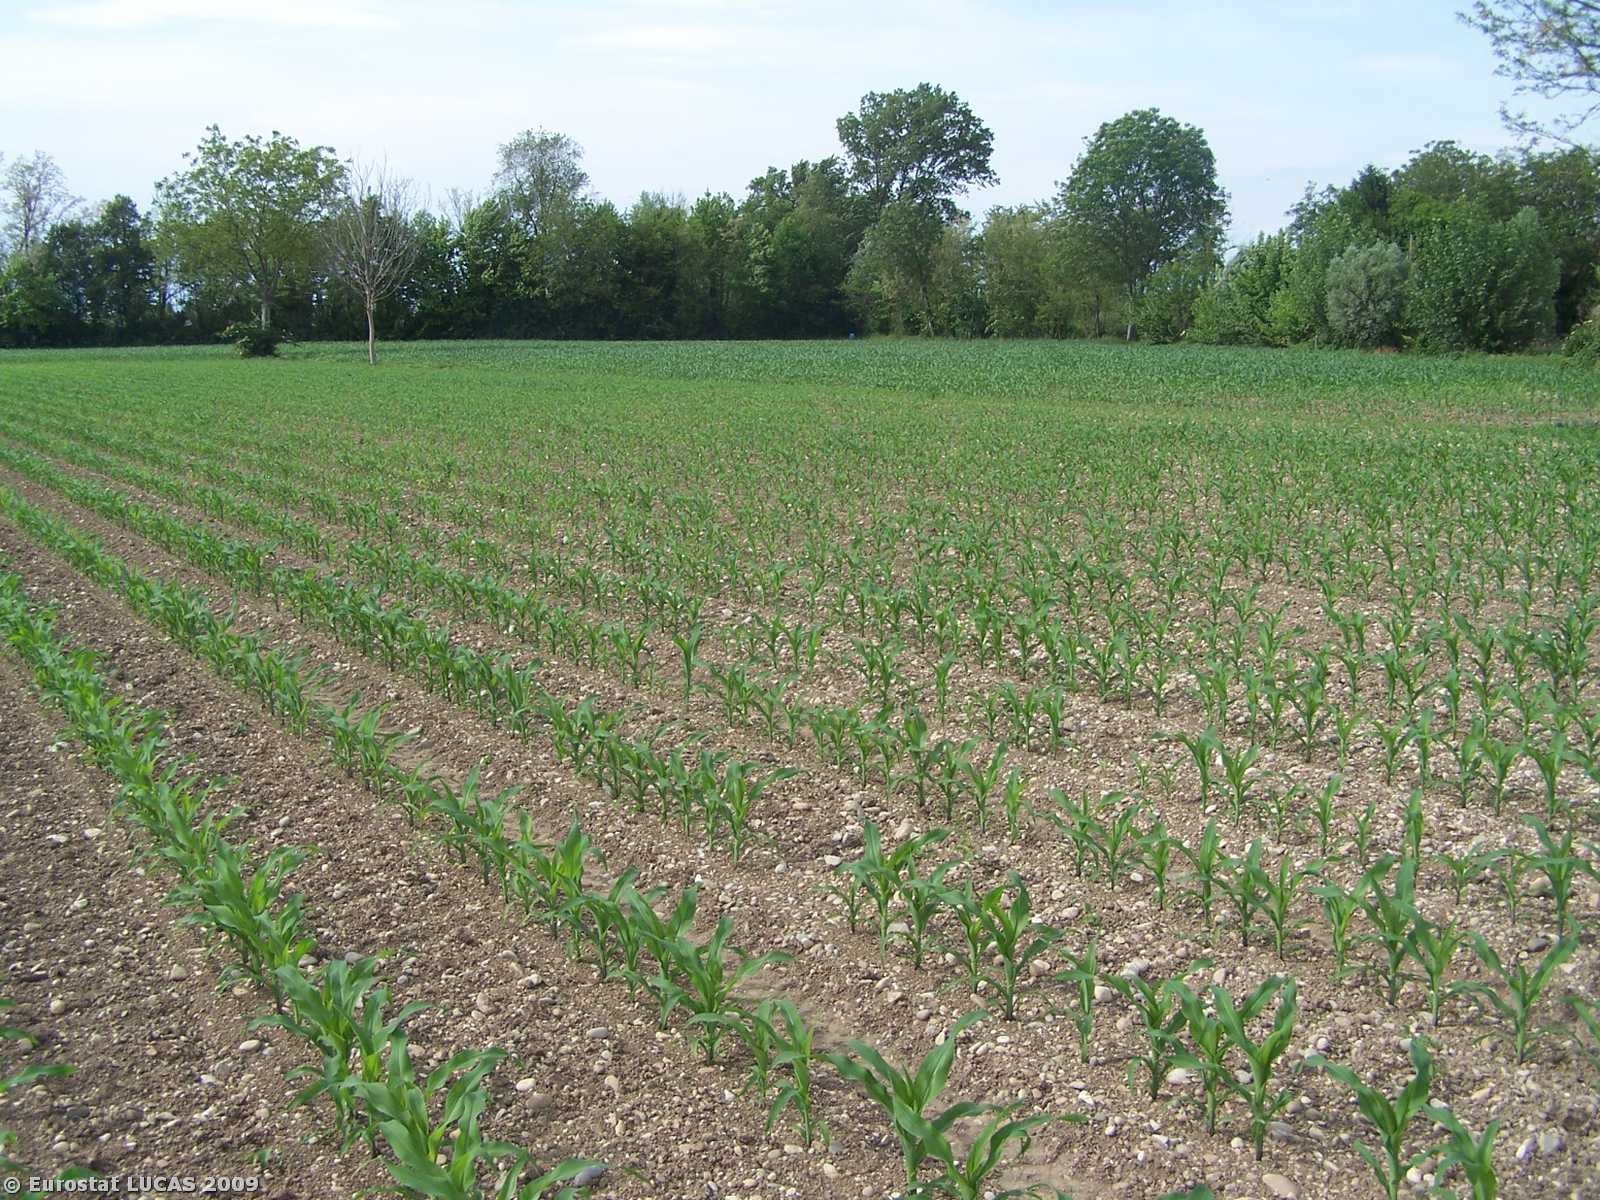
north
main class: Cropland
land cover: Maize
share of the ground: 25 - 50 %
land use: Agriculture (excluding fallow land and kitchen gardens)
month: May
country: IT
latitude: 45.9133
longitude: 12.9745
